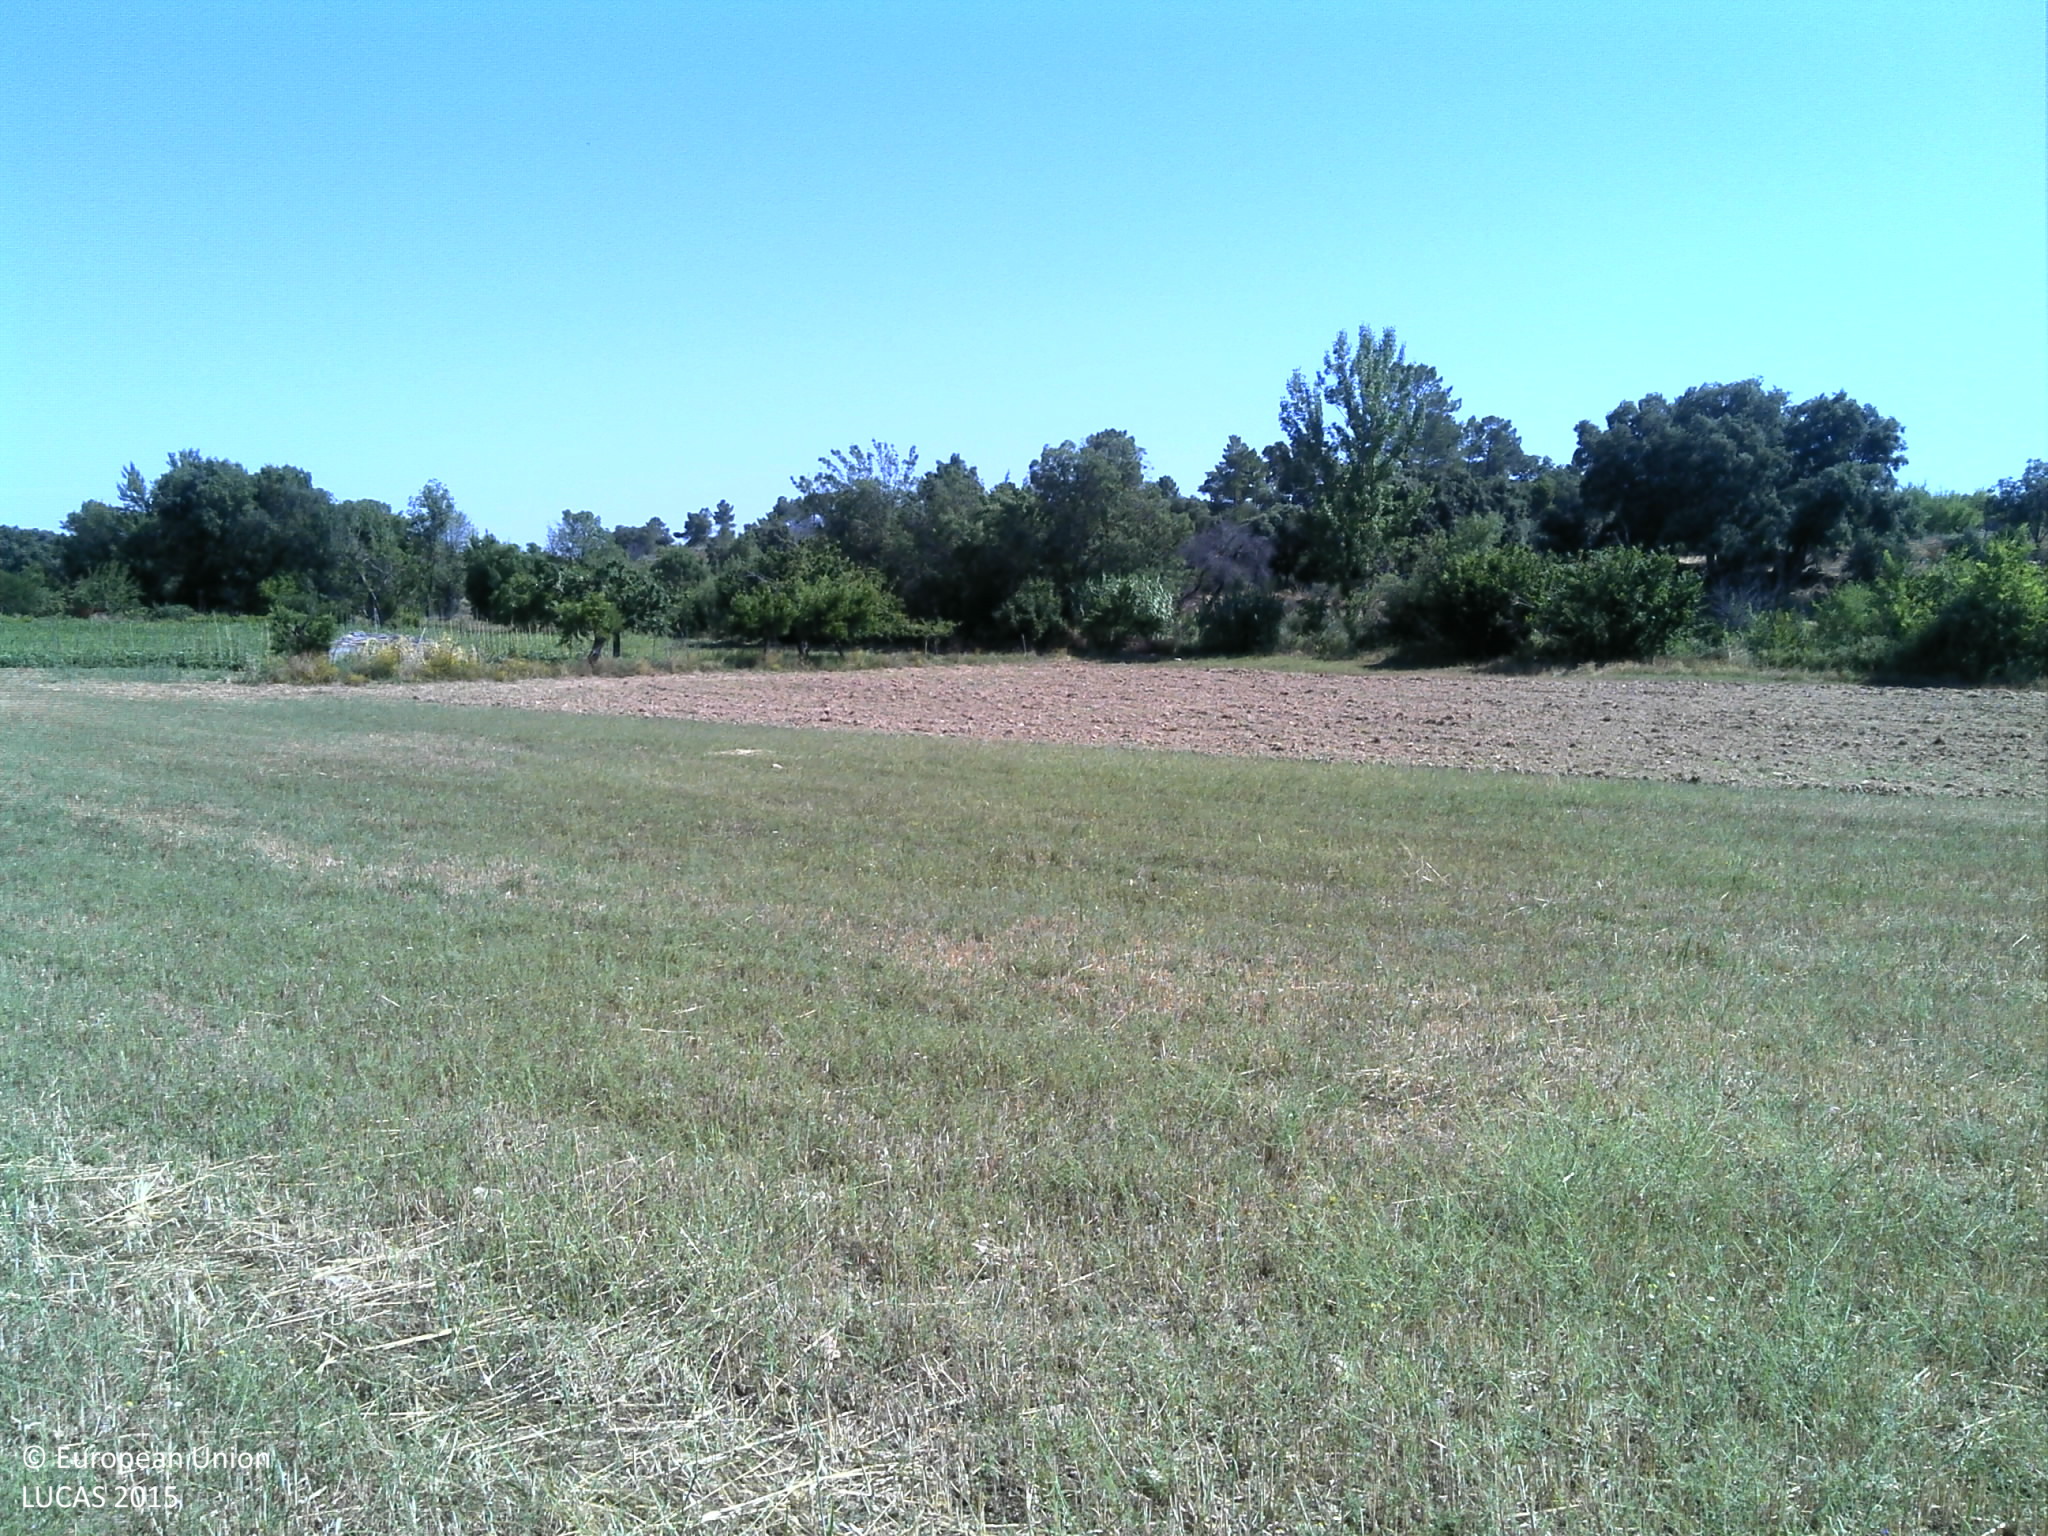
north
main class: Cropland
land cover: Oats
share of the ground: > 75 %
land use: Agriculture (excluding fallow land and kitchen gardens)
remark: Harvested field
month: June
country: PT
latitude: 40.8801
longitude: -7.0645
